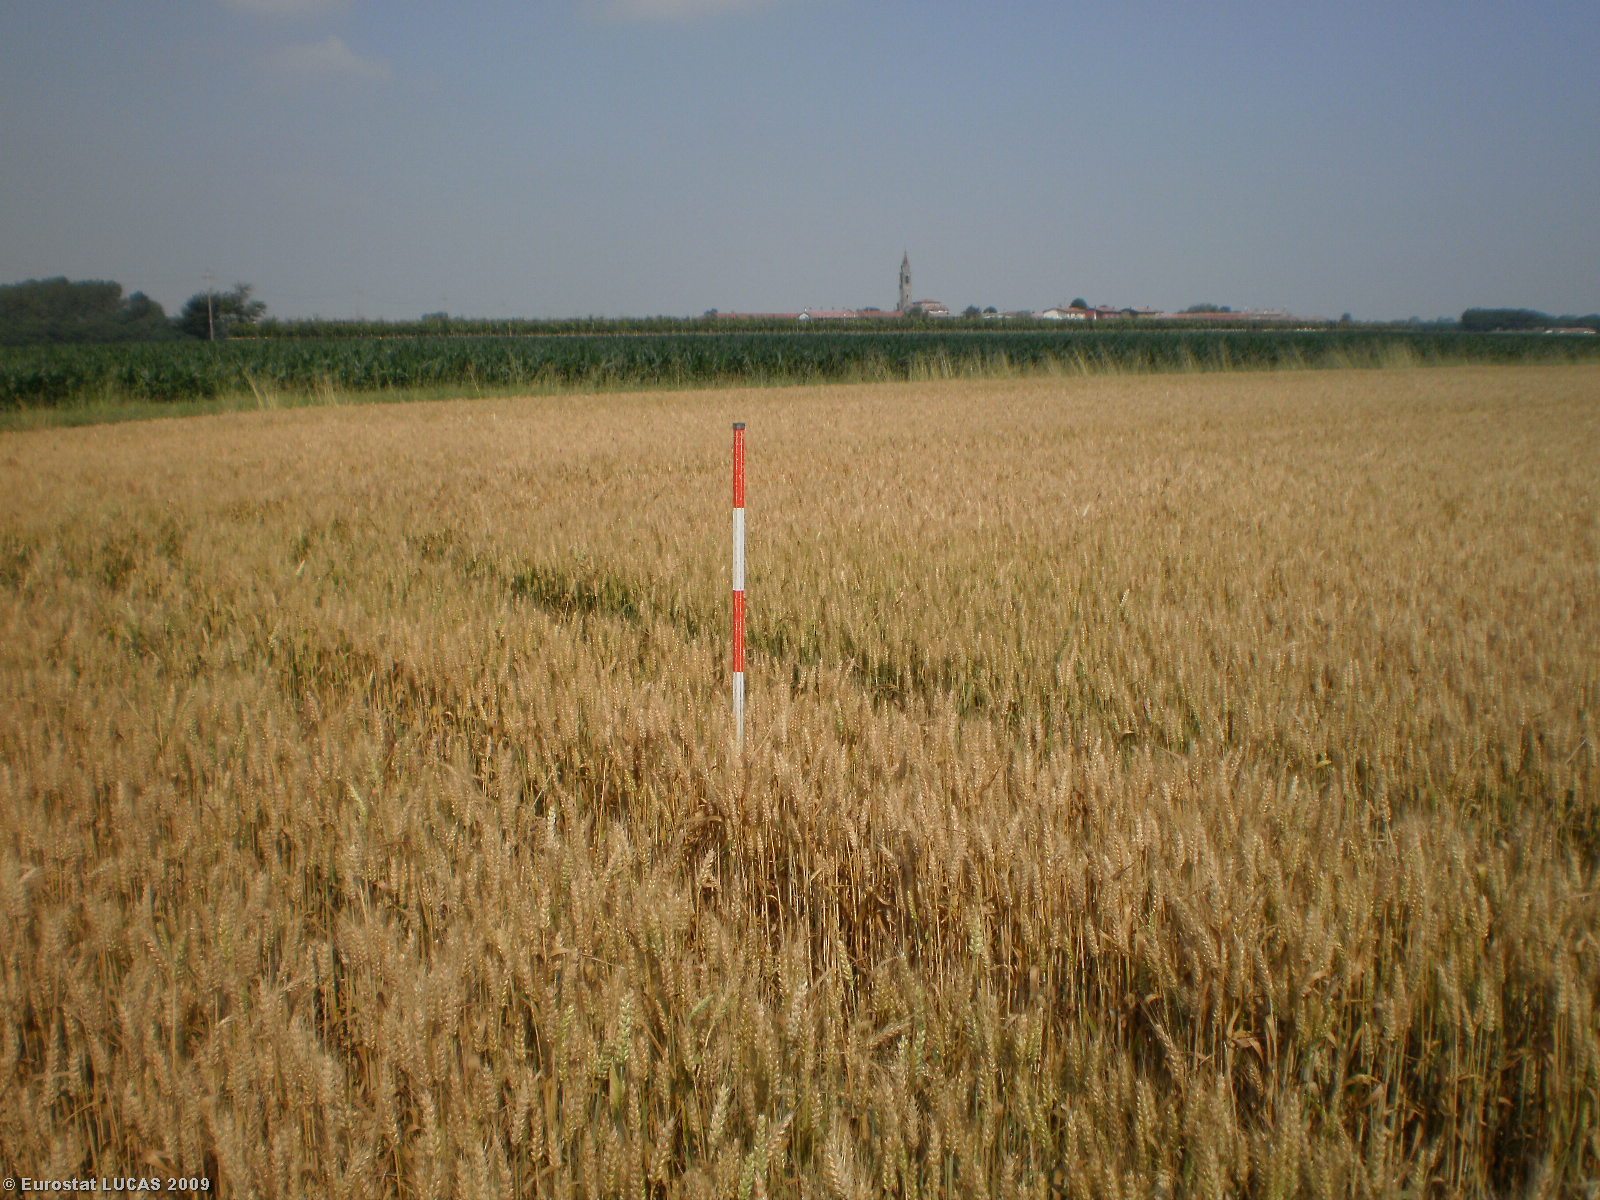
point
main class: Cropland
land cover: Common wheat
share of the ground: > 75 %
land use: Agriculture (excluding fallow land and kitchen gardens)
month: June
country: IT
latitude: 45.1073
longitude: 10.3425
